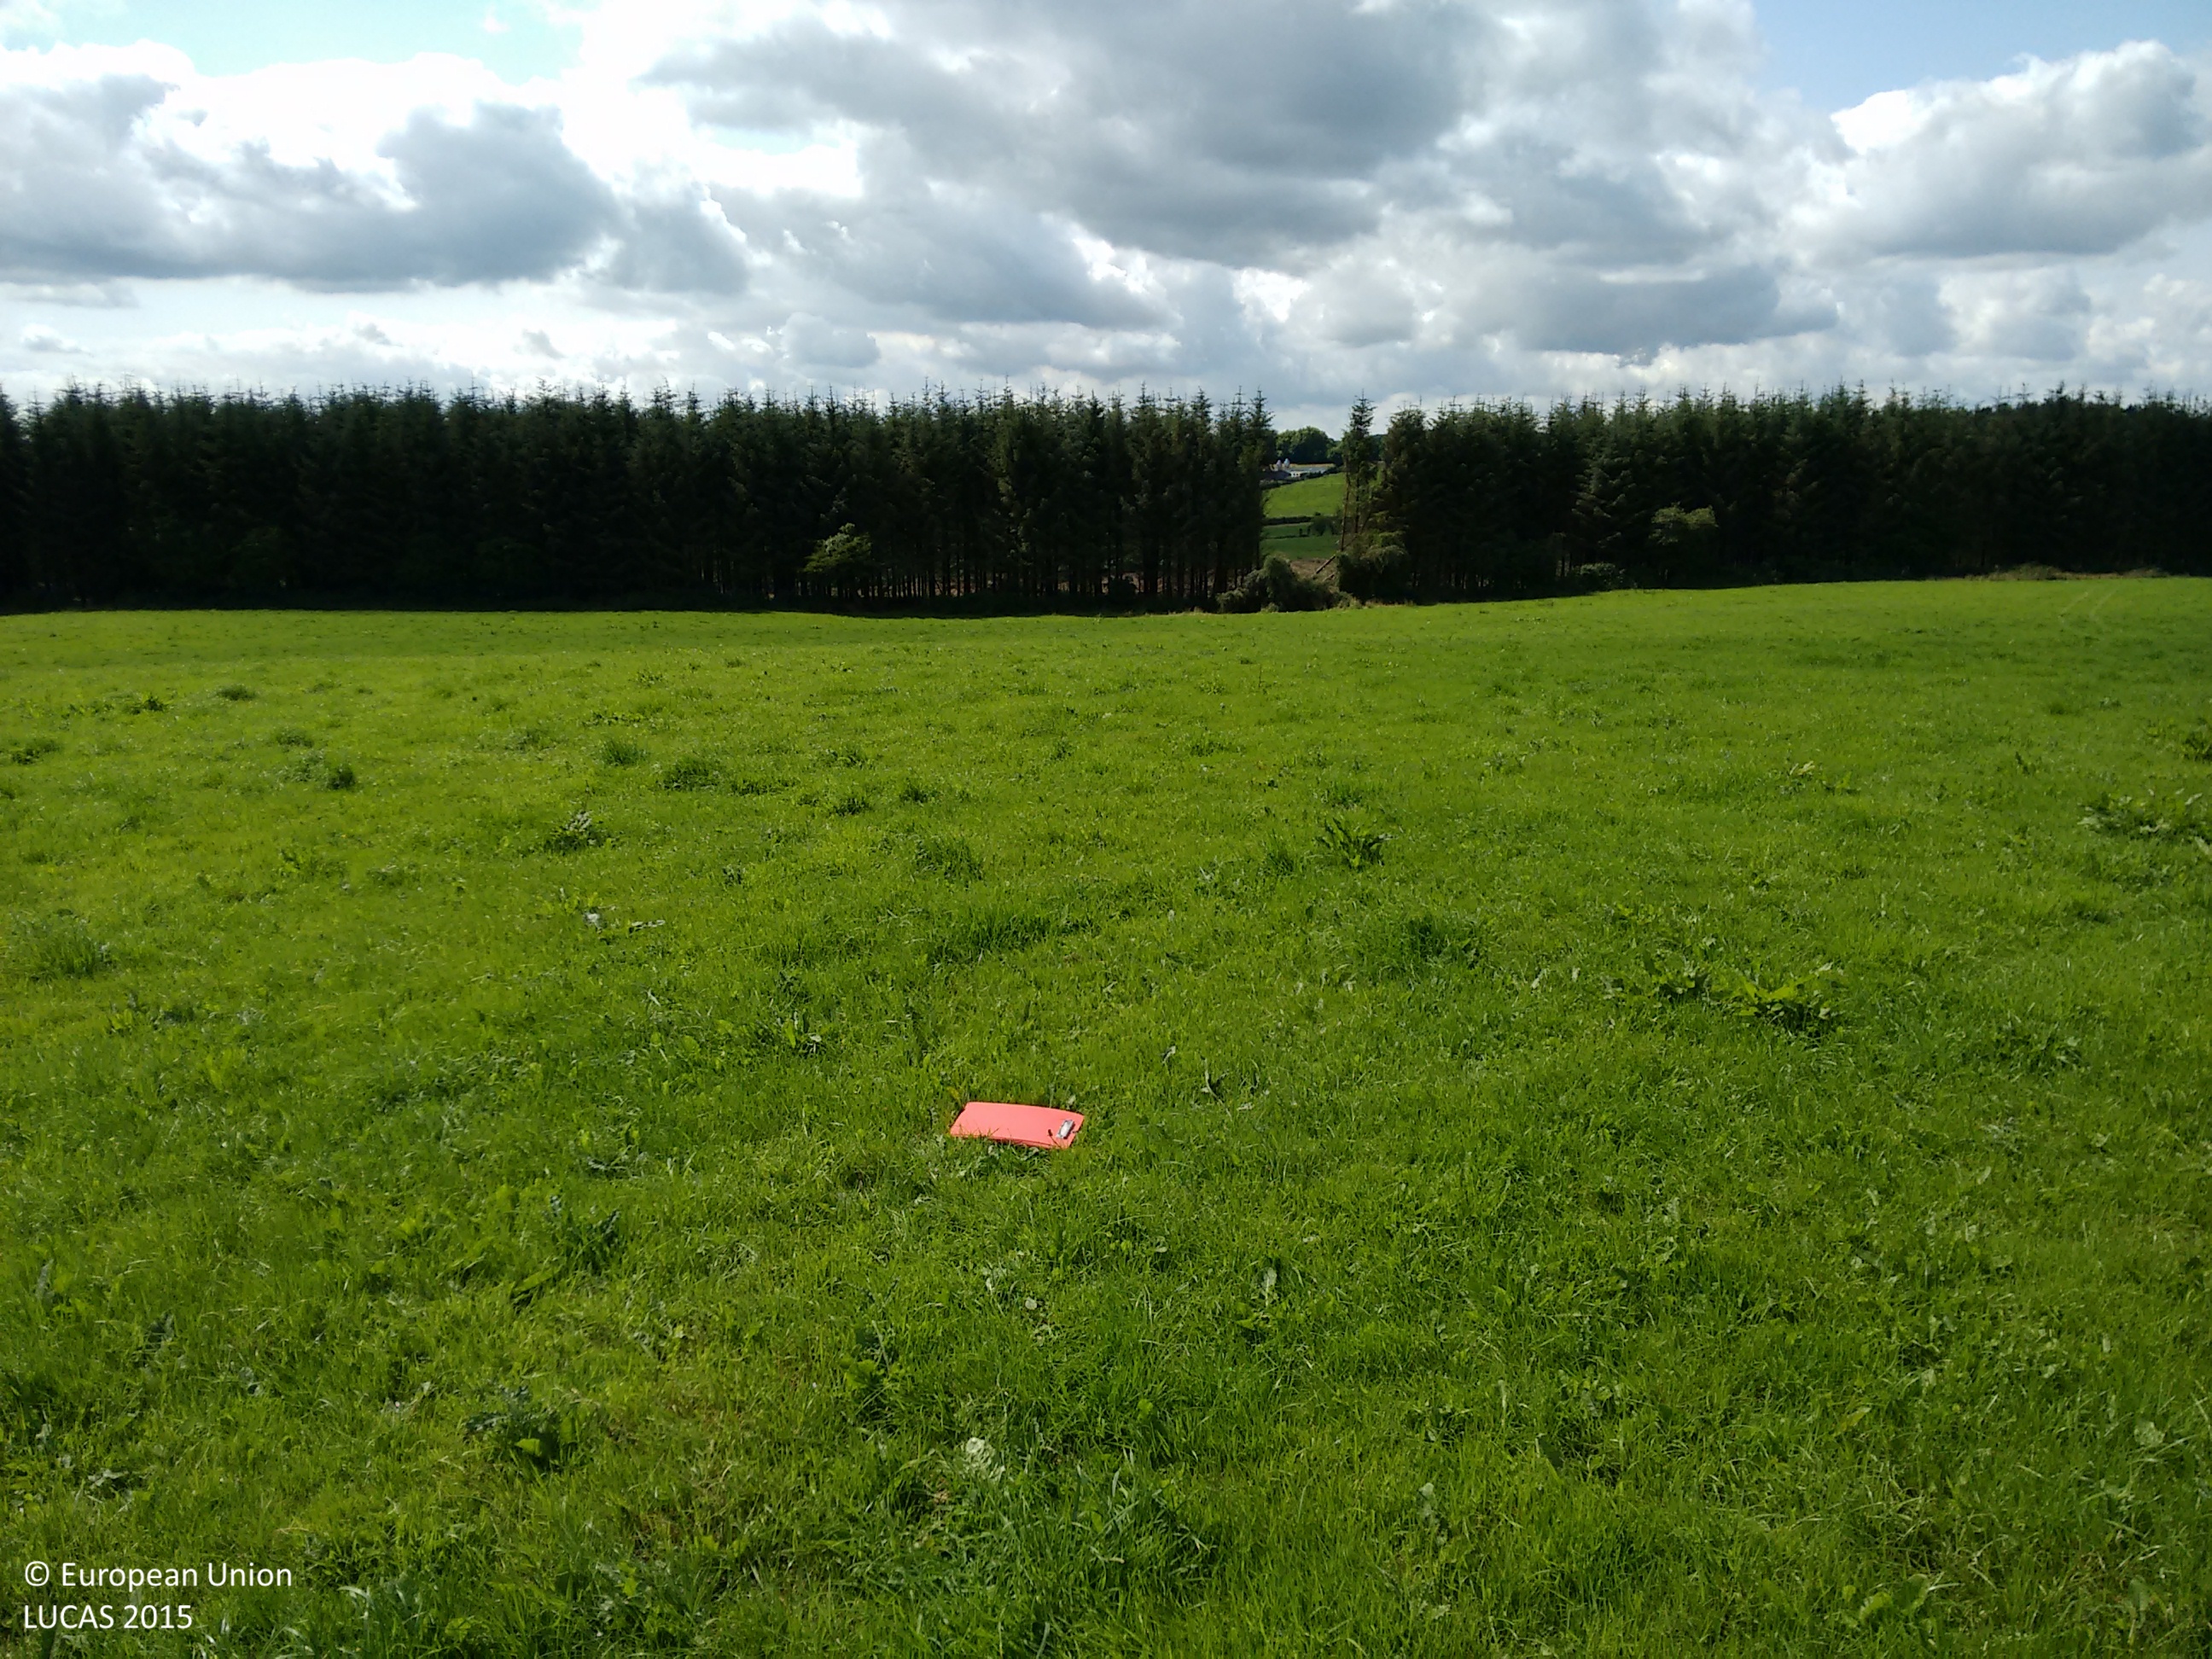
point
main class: Grassland
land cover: Grassland without tree/shrub cover
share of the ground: > 75 %
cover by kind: herbaceous plants 100 %
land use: Agriculture (excluding fallow land and kitchen gardens)
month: July
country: IE
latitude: 52.6346
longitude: -7.5826
